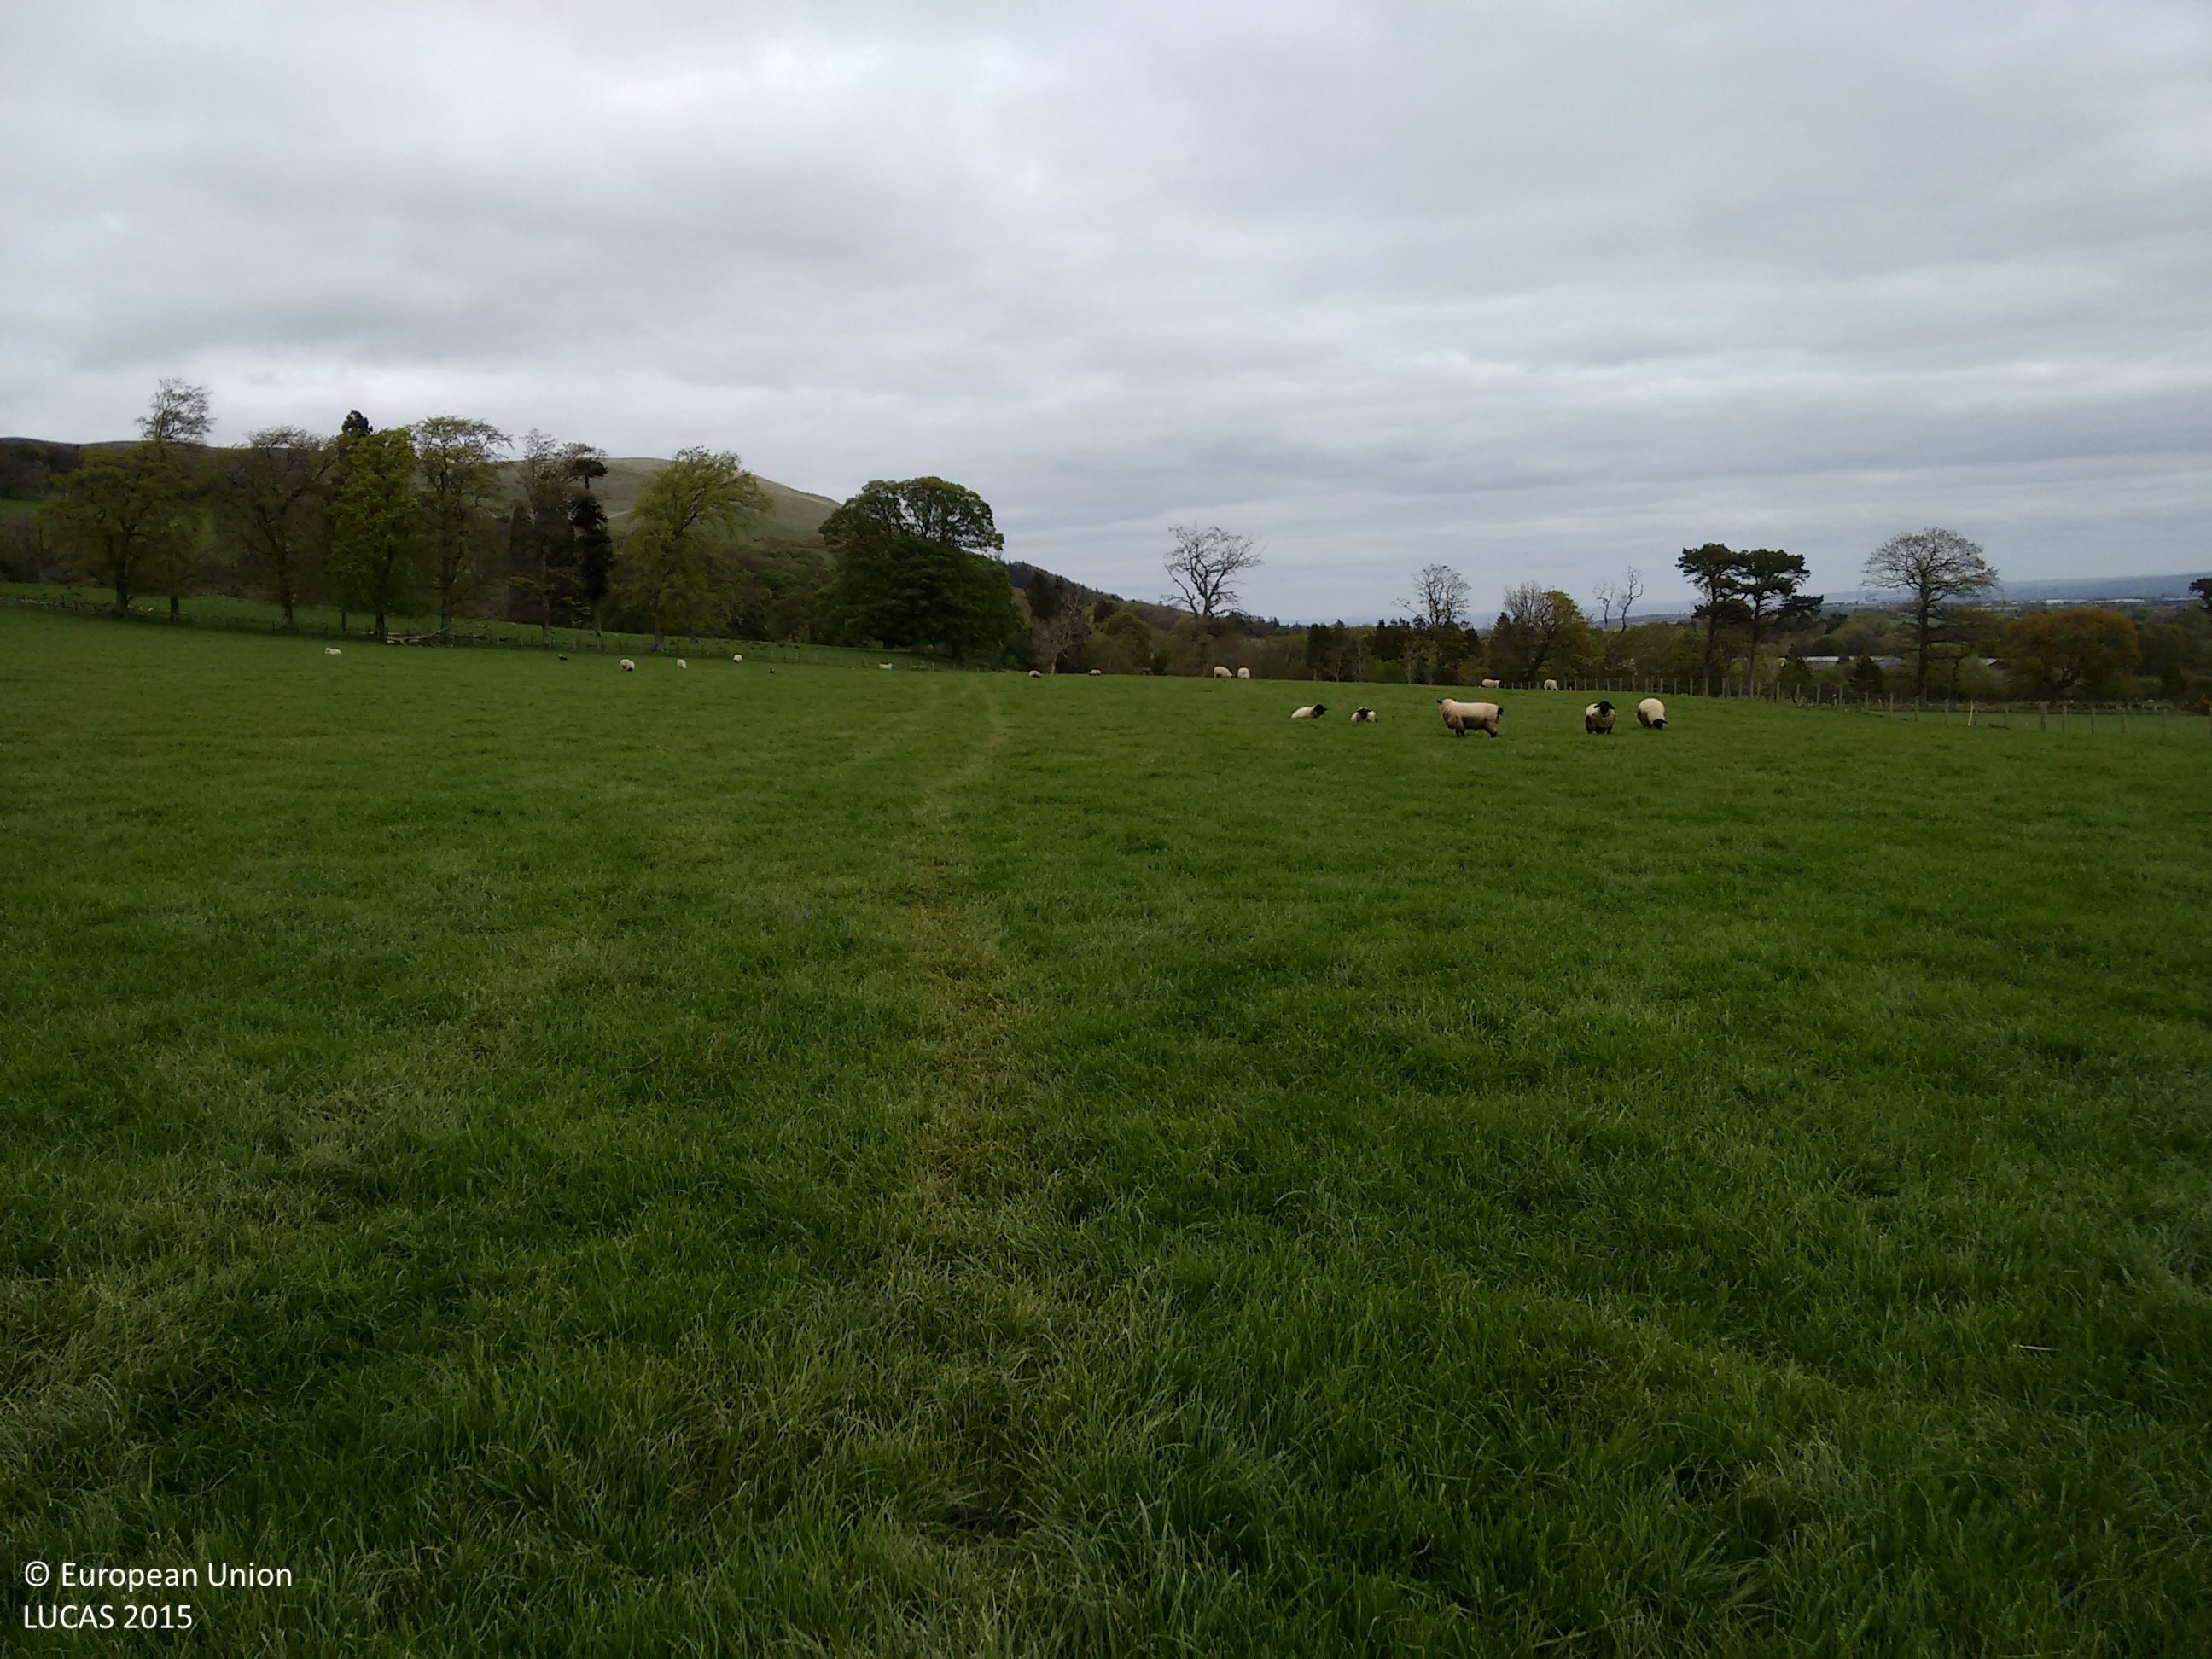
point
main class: Grassland
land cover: Grassland without tree/shrub cover
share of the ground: > 75 %
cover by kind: herbaceous plants 100 %
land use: Agriculture (excluding fallow land and kitchen gardens)
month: May
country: GB
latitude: 55.8644
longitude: -3.2230
